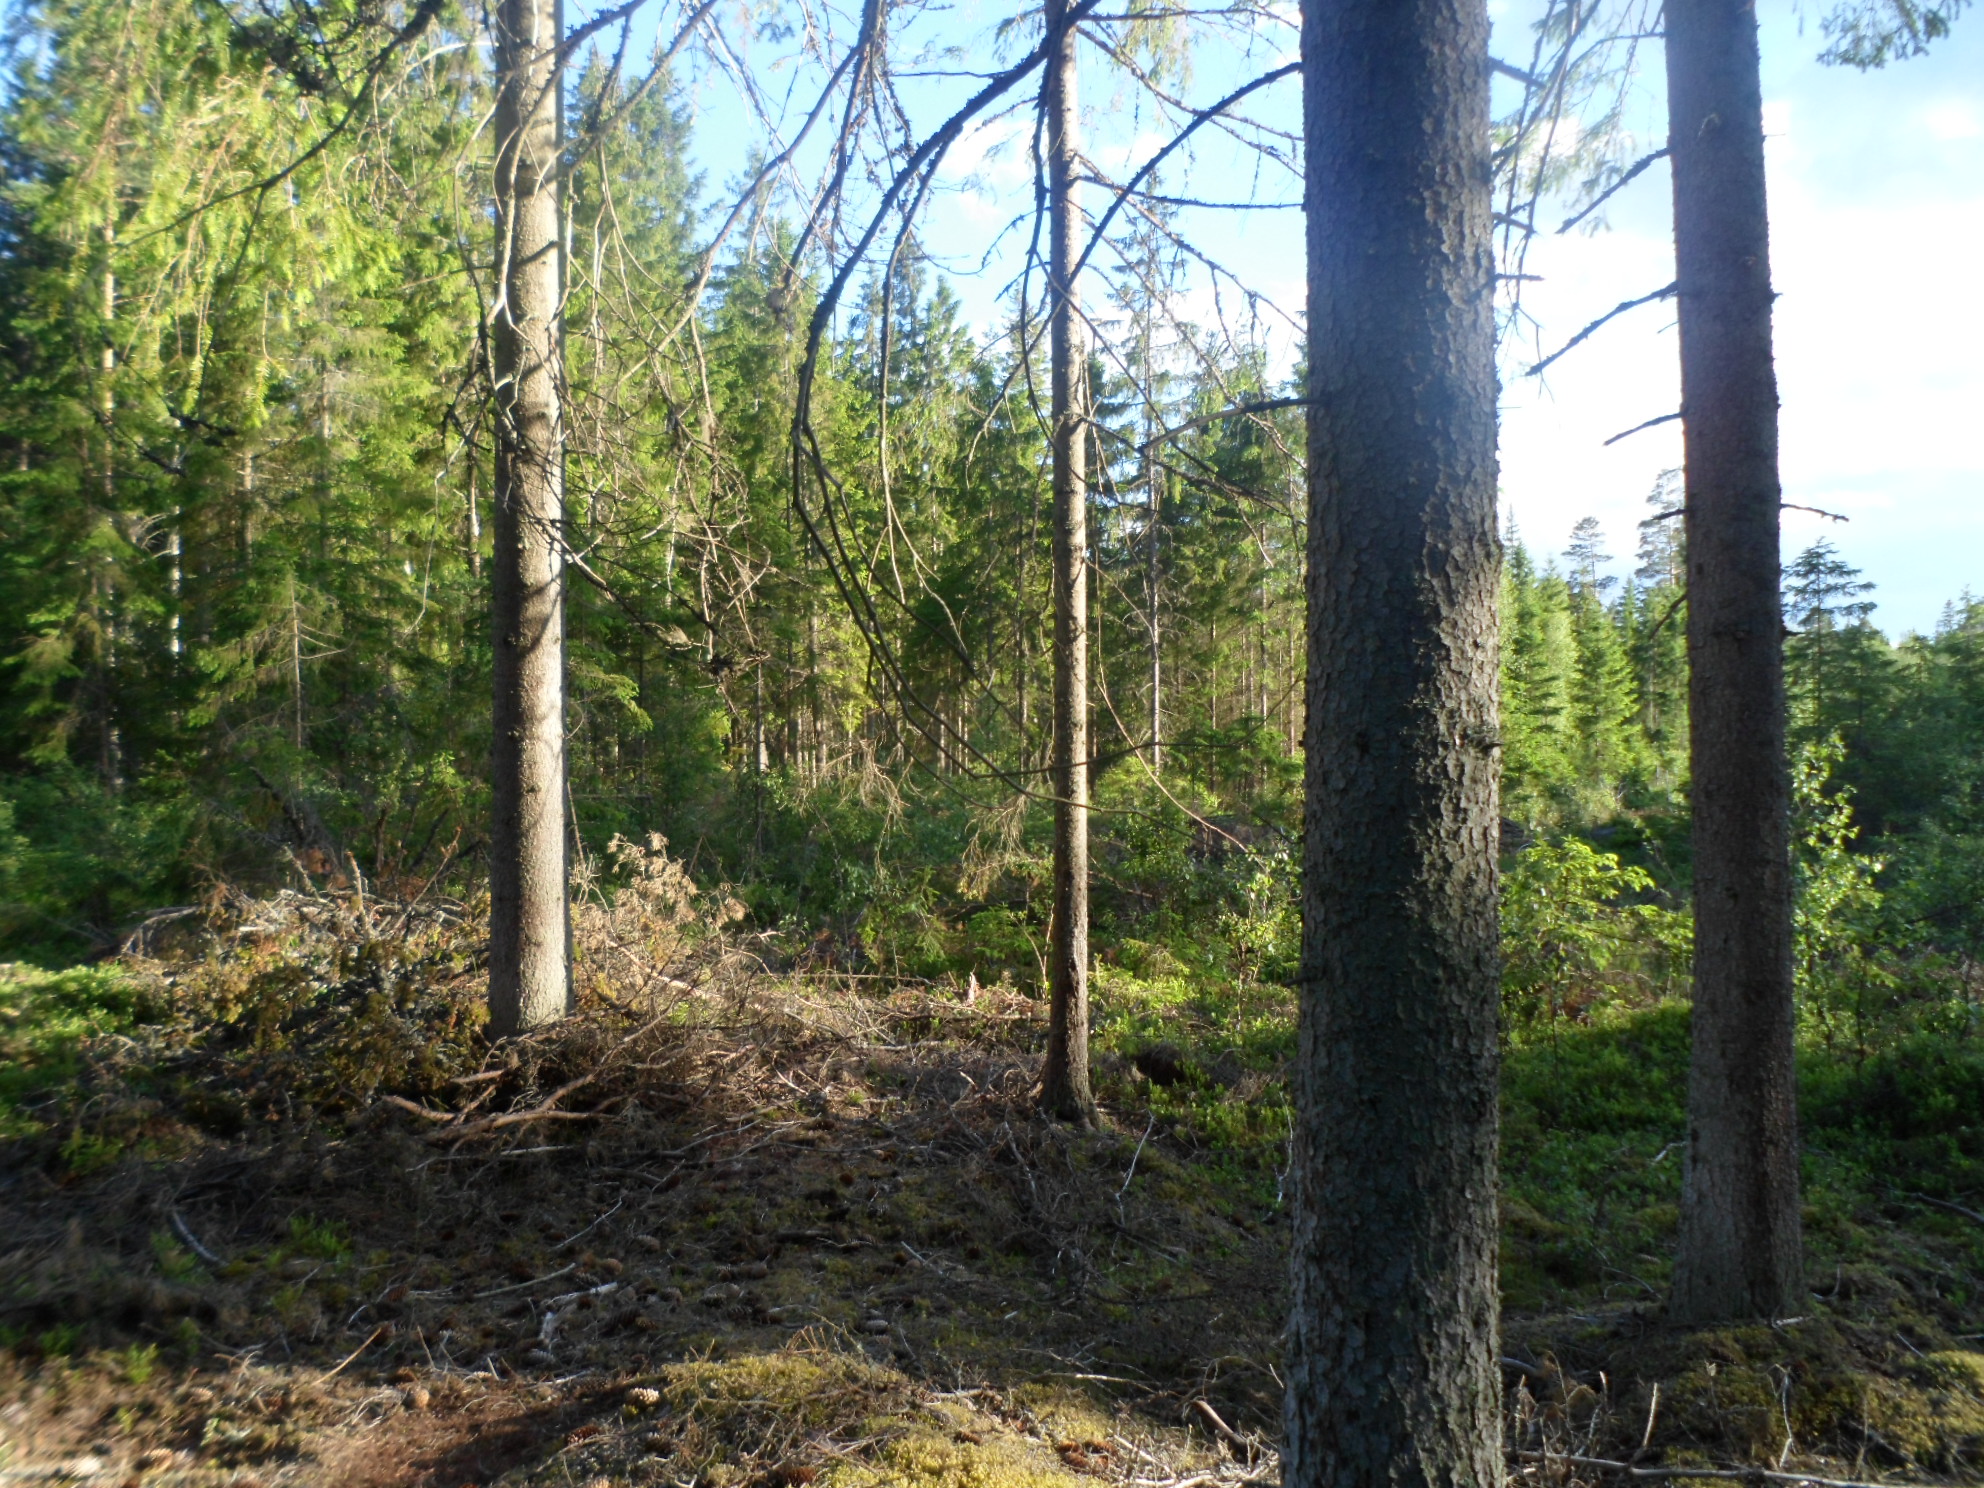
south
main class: Woodland
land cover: Spruce dominated coniferous woodland
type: boreal forest
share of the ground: 50 - 75 %
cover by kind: coniferous forest trees 55 %, shrubs 20 %, lichens and mosses 20 %, herbaceous plants 5 %
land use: Forestry
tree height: > 5 m
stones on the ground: 10 - 25 %
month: June
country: SE
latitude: 57.2382
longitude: 14.6521
